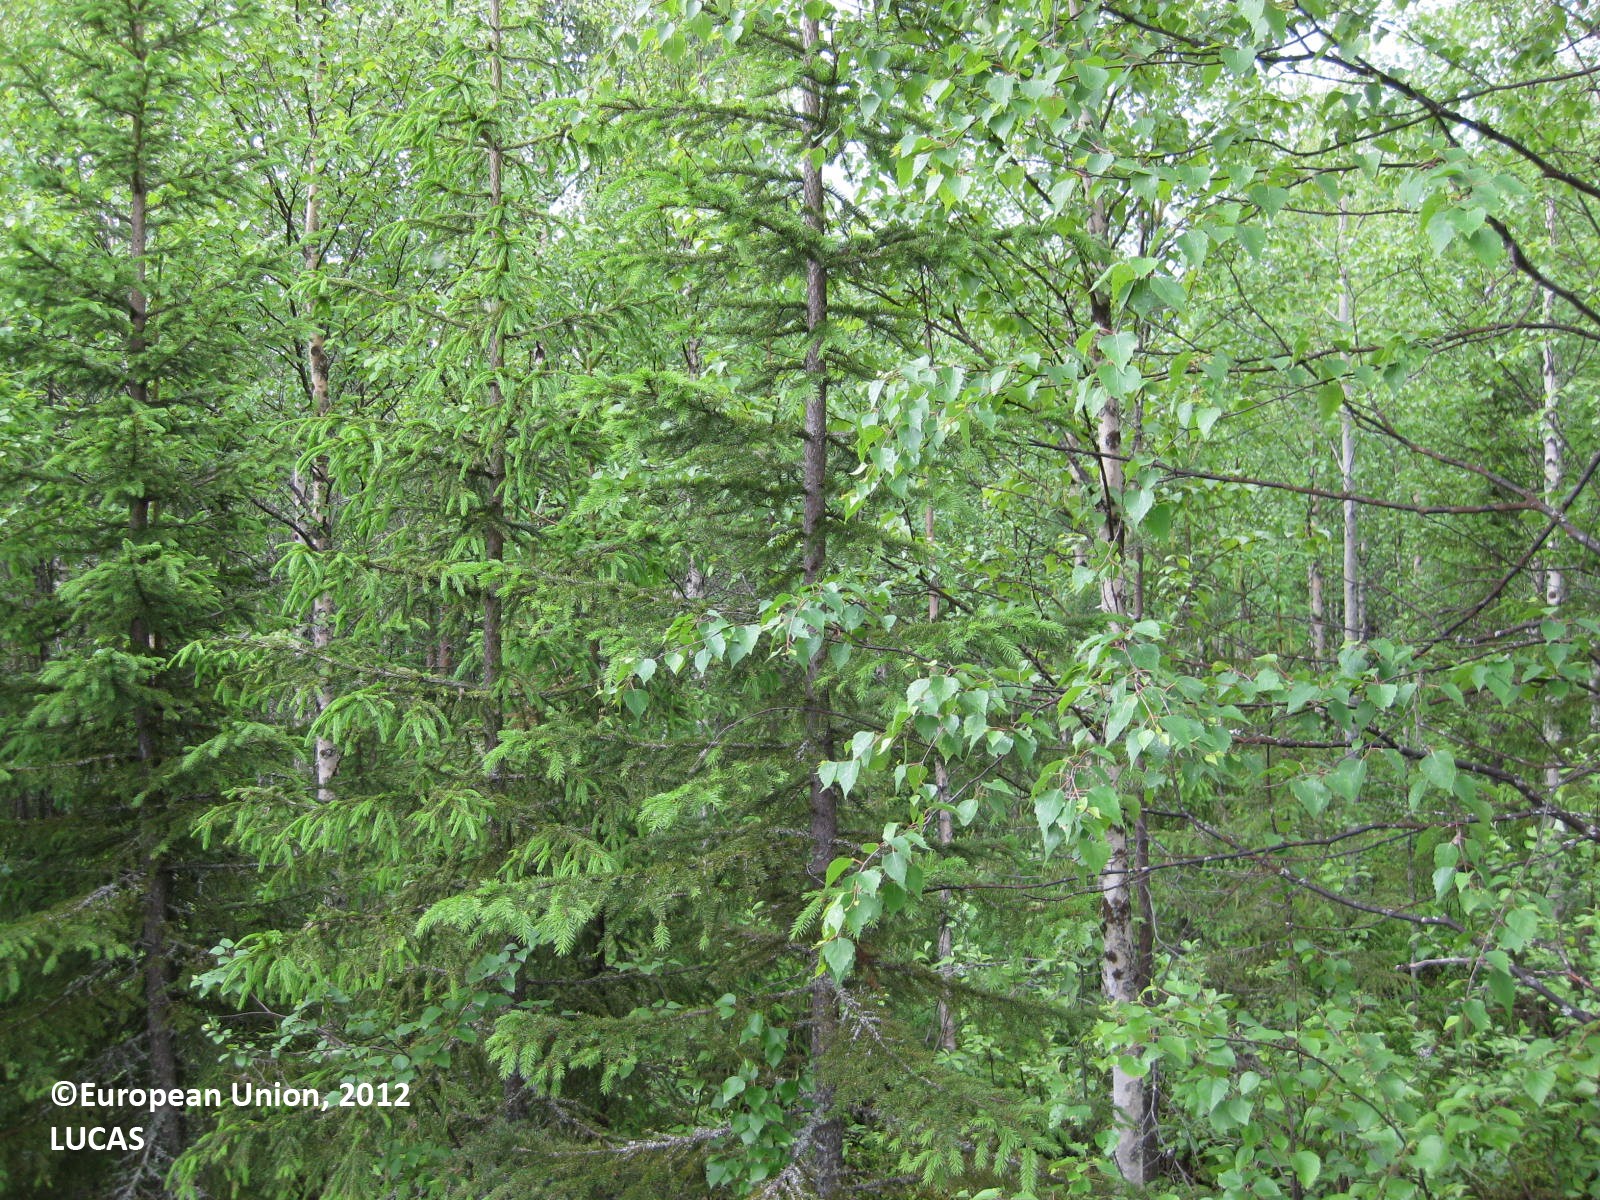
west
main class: Woodland
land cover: Spruce dominated mixed woodland
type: boreal forest
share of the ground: > 75 %
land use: Forestry
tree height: > 5 m
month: June
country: FI
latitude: 65.3003
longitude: 28.2803
